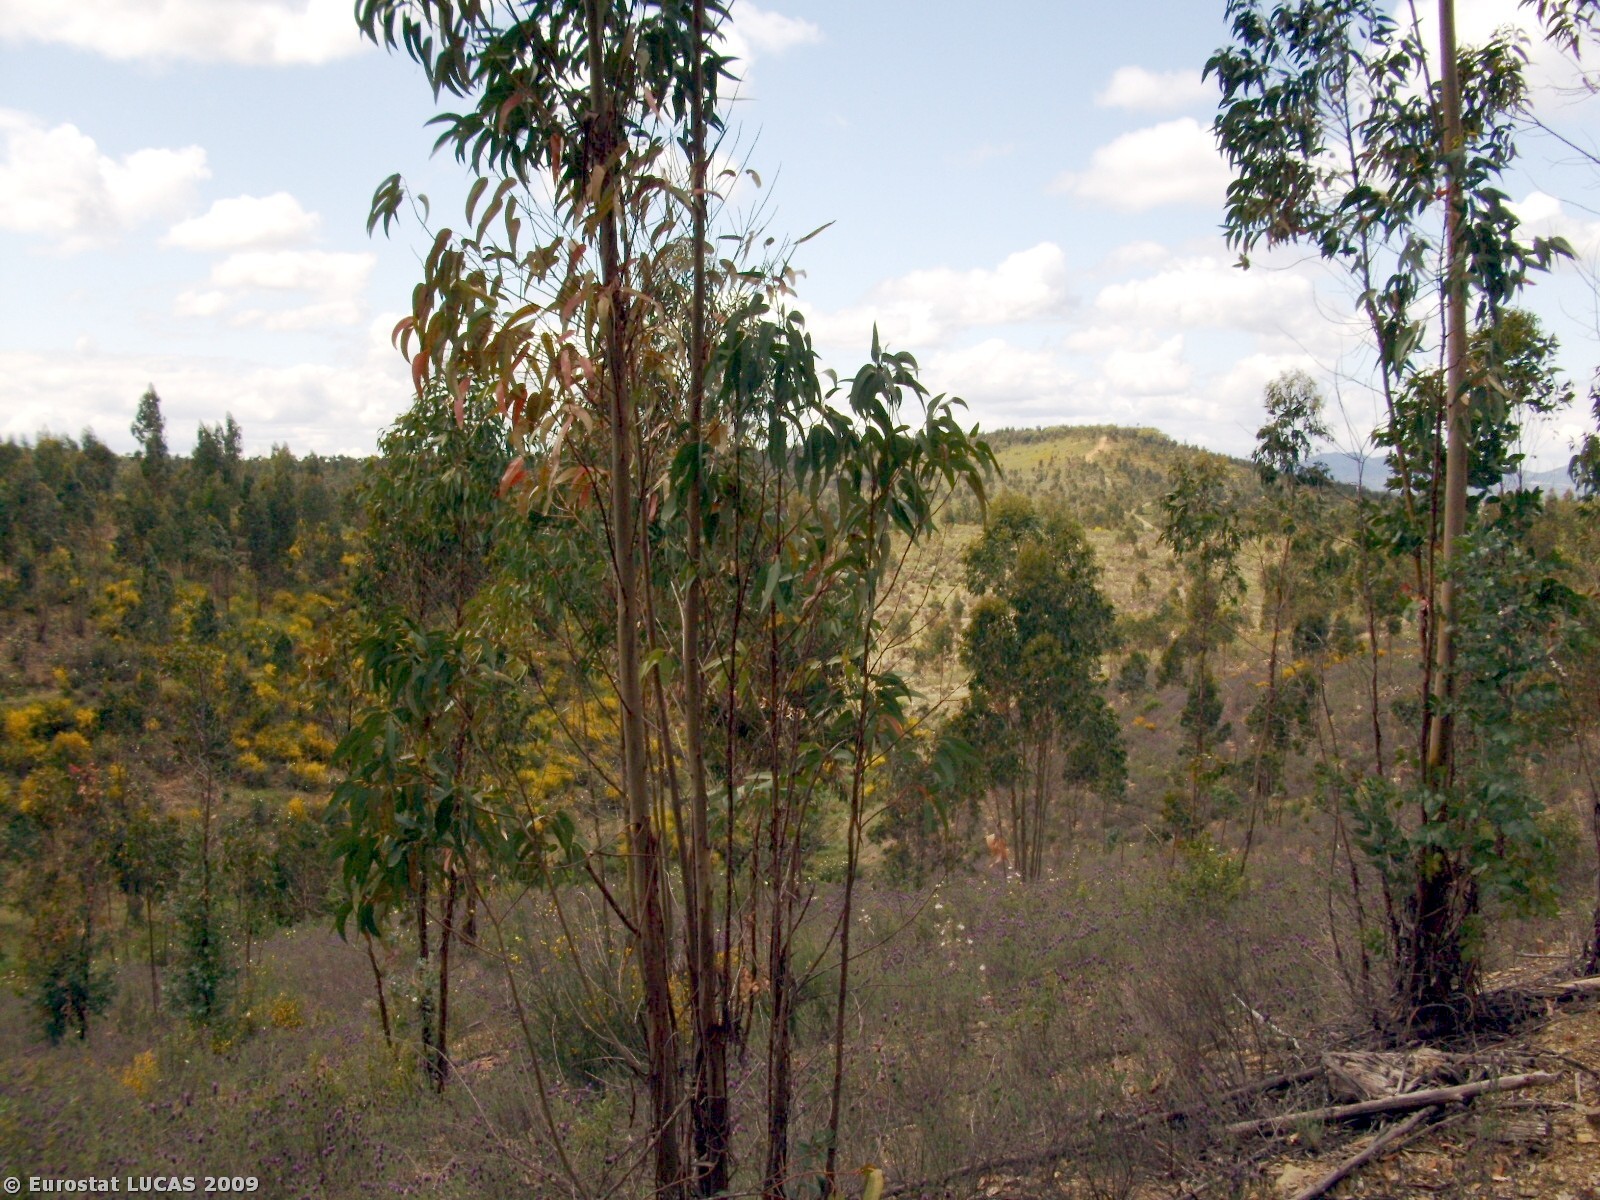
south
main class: Woodland
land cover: Broadleaved woodland
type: plantations and self-sown exotic forest
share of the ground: 50 - 75 %
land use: Forestry
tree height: > 5 m
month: April
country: PT
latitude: 39.6511
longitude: -7.5435
